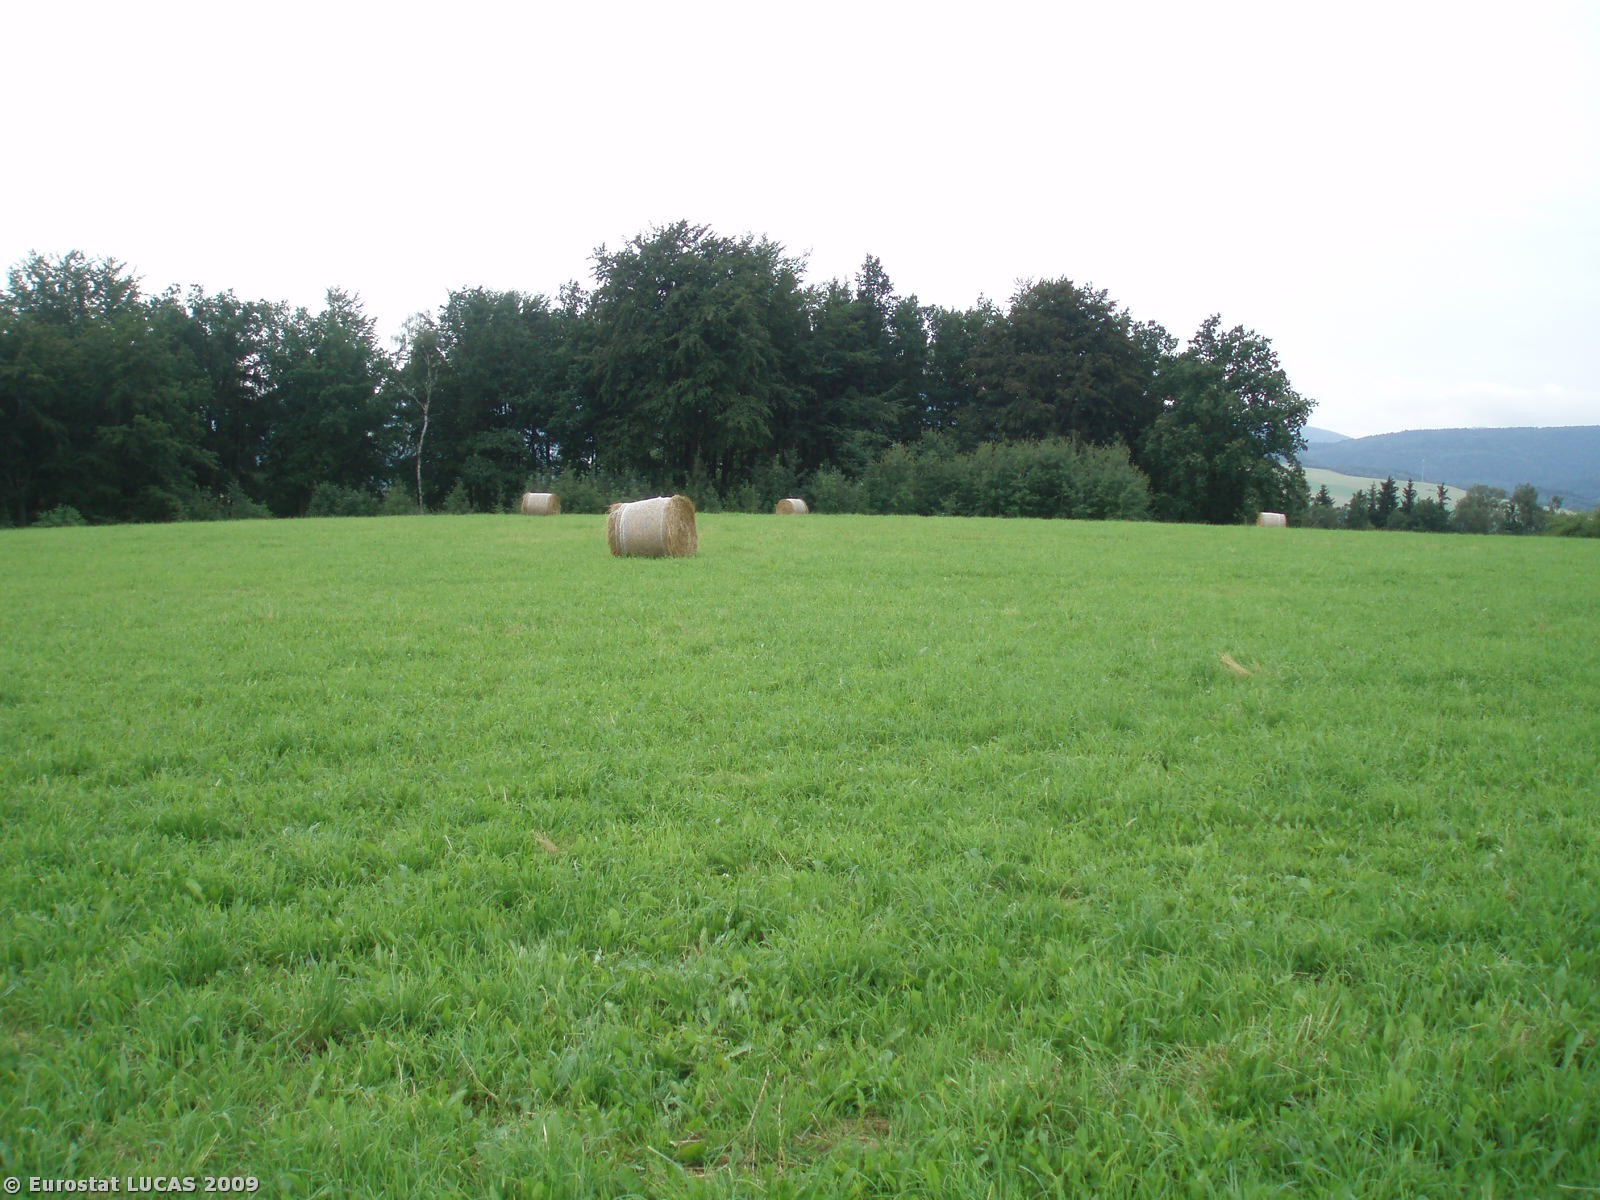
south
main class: Grassland
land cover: Grassland without tree/shrub cover
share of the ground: > 75 %
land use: Agriculture (excluding fallow land and kitchen gardens)
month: July
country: CZ
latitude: 50.8318
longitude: 14.9865
